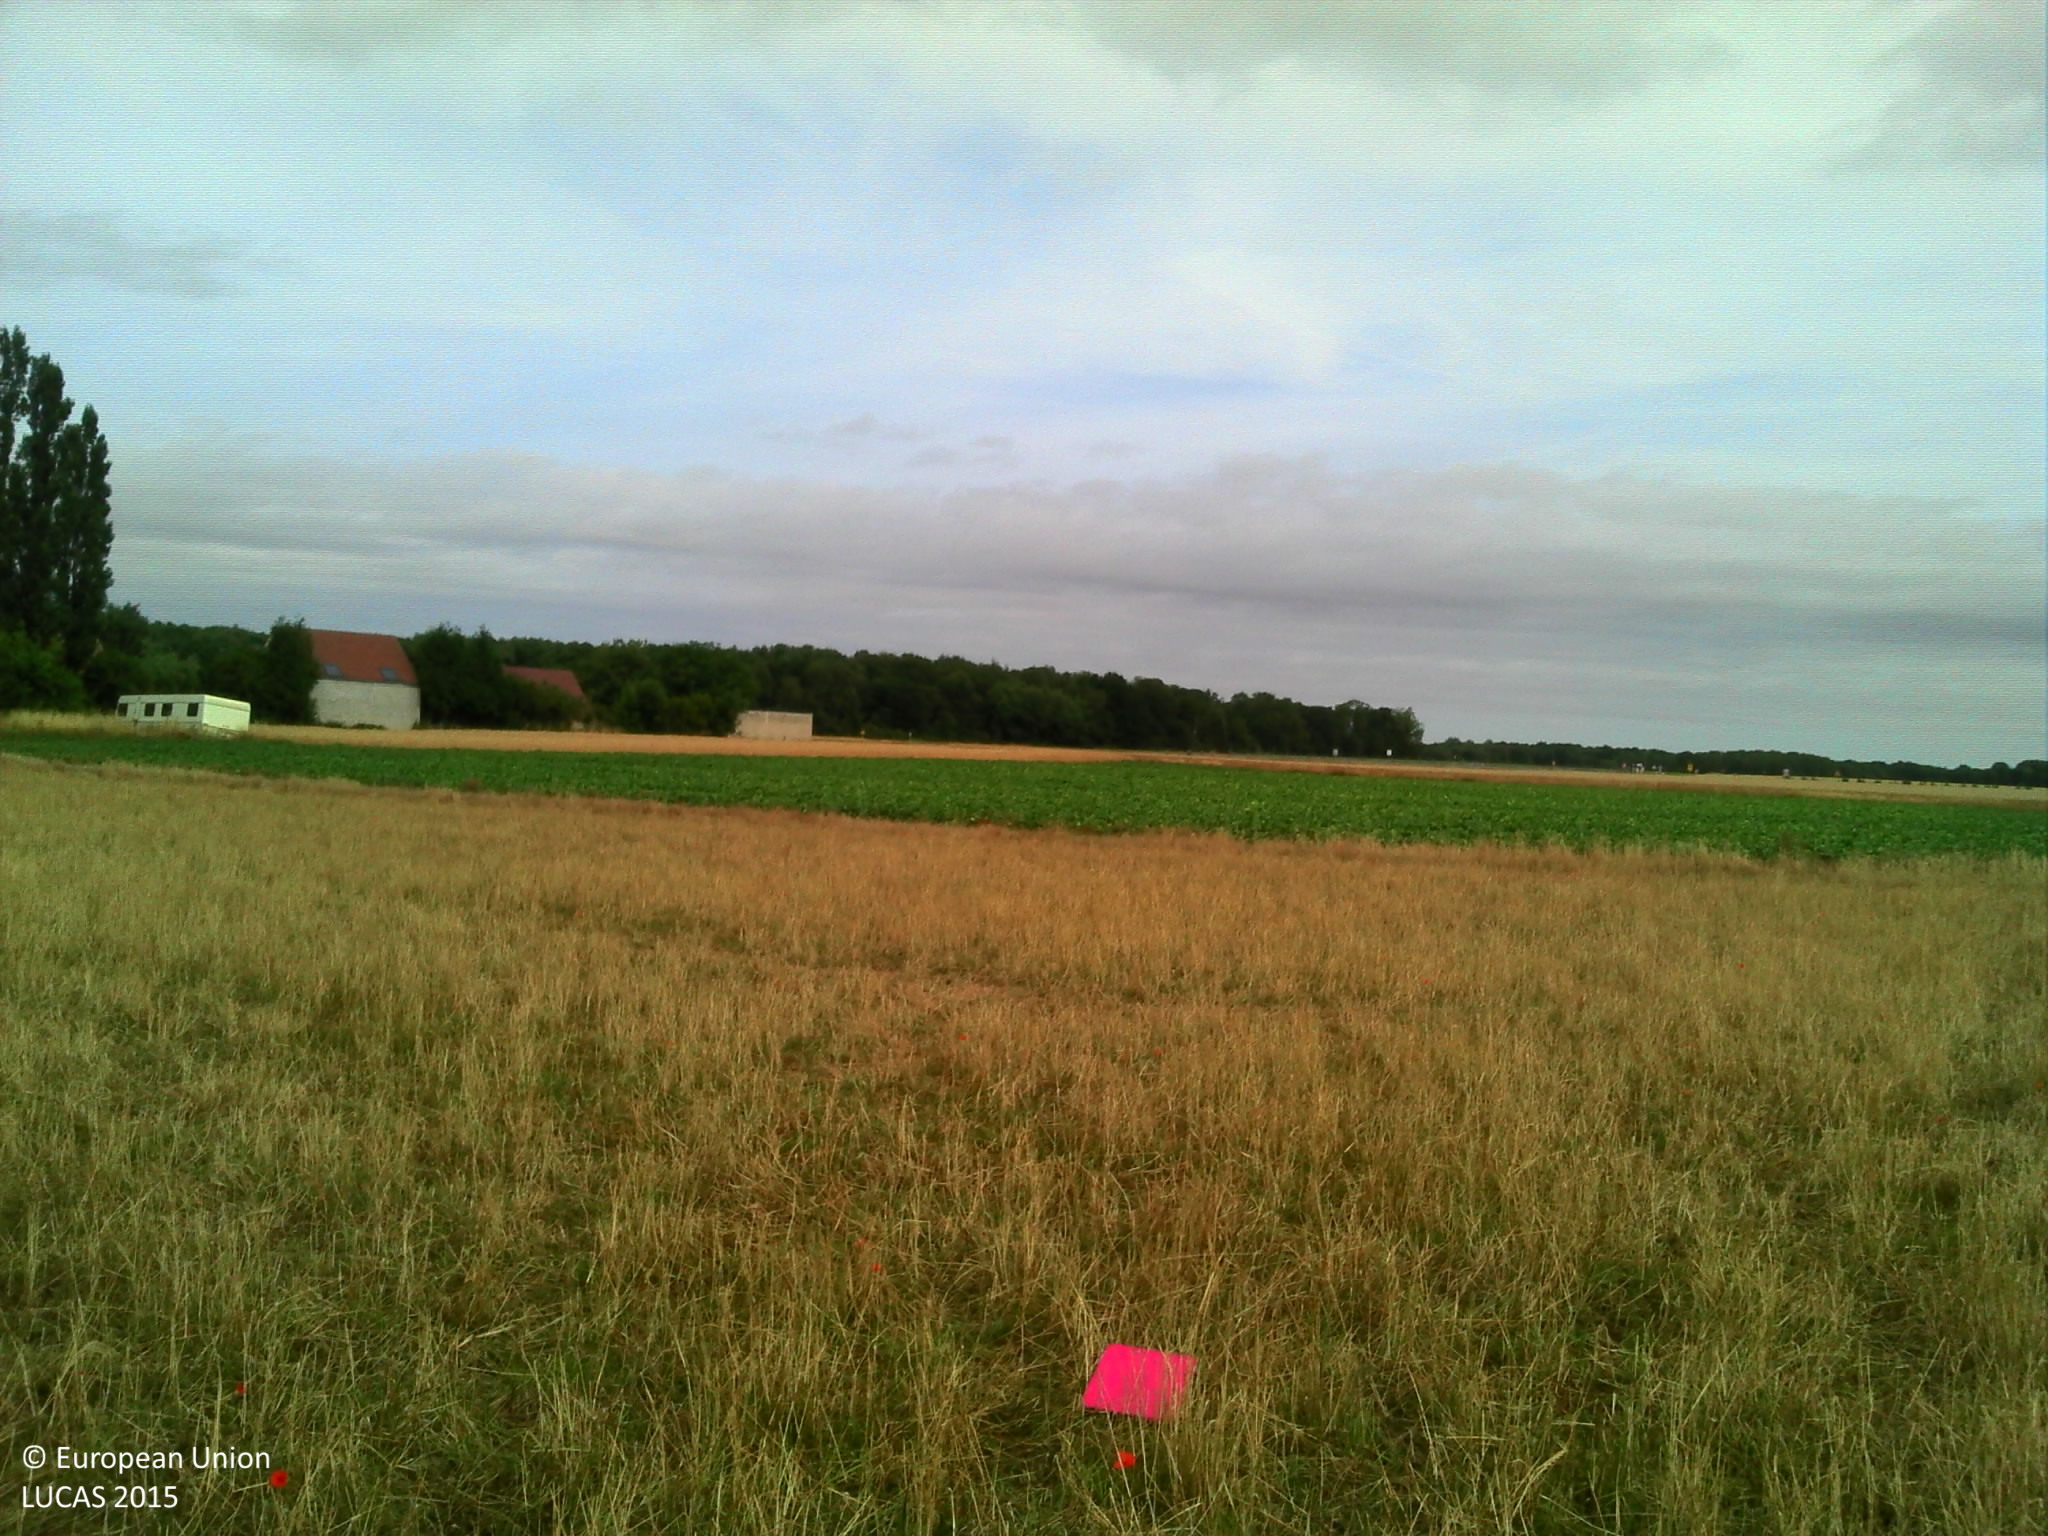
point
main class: Grassland
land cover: Grassland without tree/shrub cover
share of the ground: > 75 %
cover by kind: herbaceous plants 100 %
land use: Agriculture (excluding fallow land and kitchen gardens)
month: July
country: FR
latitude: 49.1666
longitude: 2.8723
